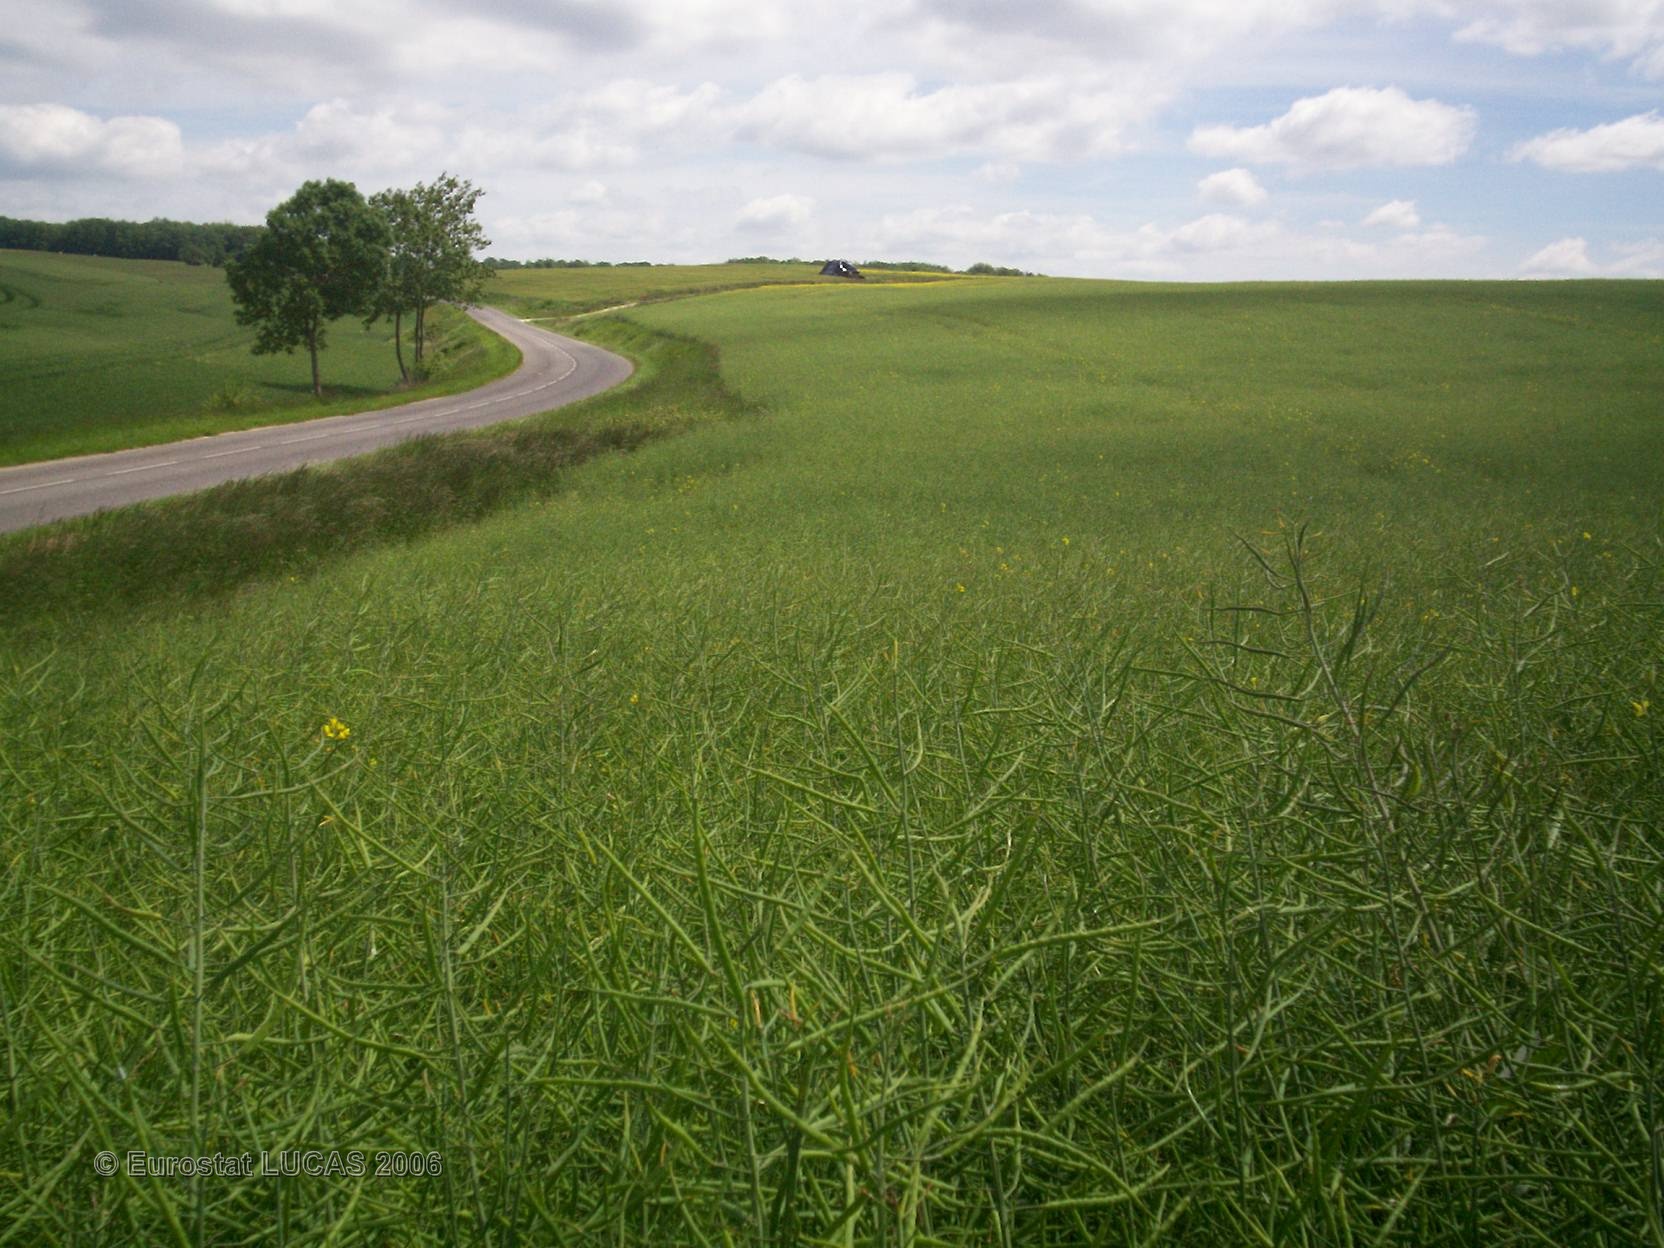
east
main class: Cropland
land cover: Rape and turnip rape
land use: Agriculture (excluding fallow land and kitchen gardens)
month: June
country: FR
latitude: 49.2307
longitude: 5.0679
